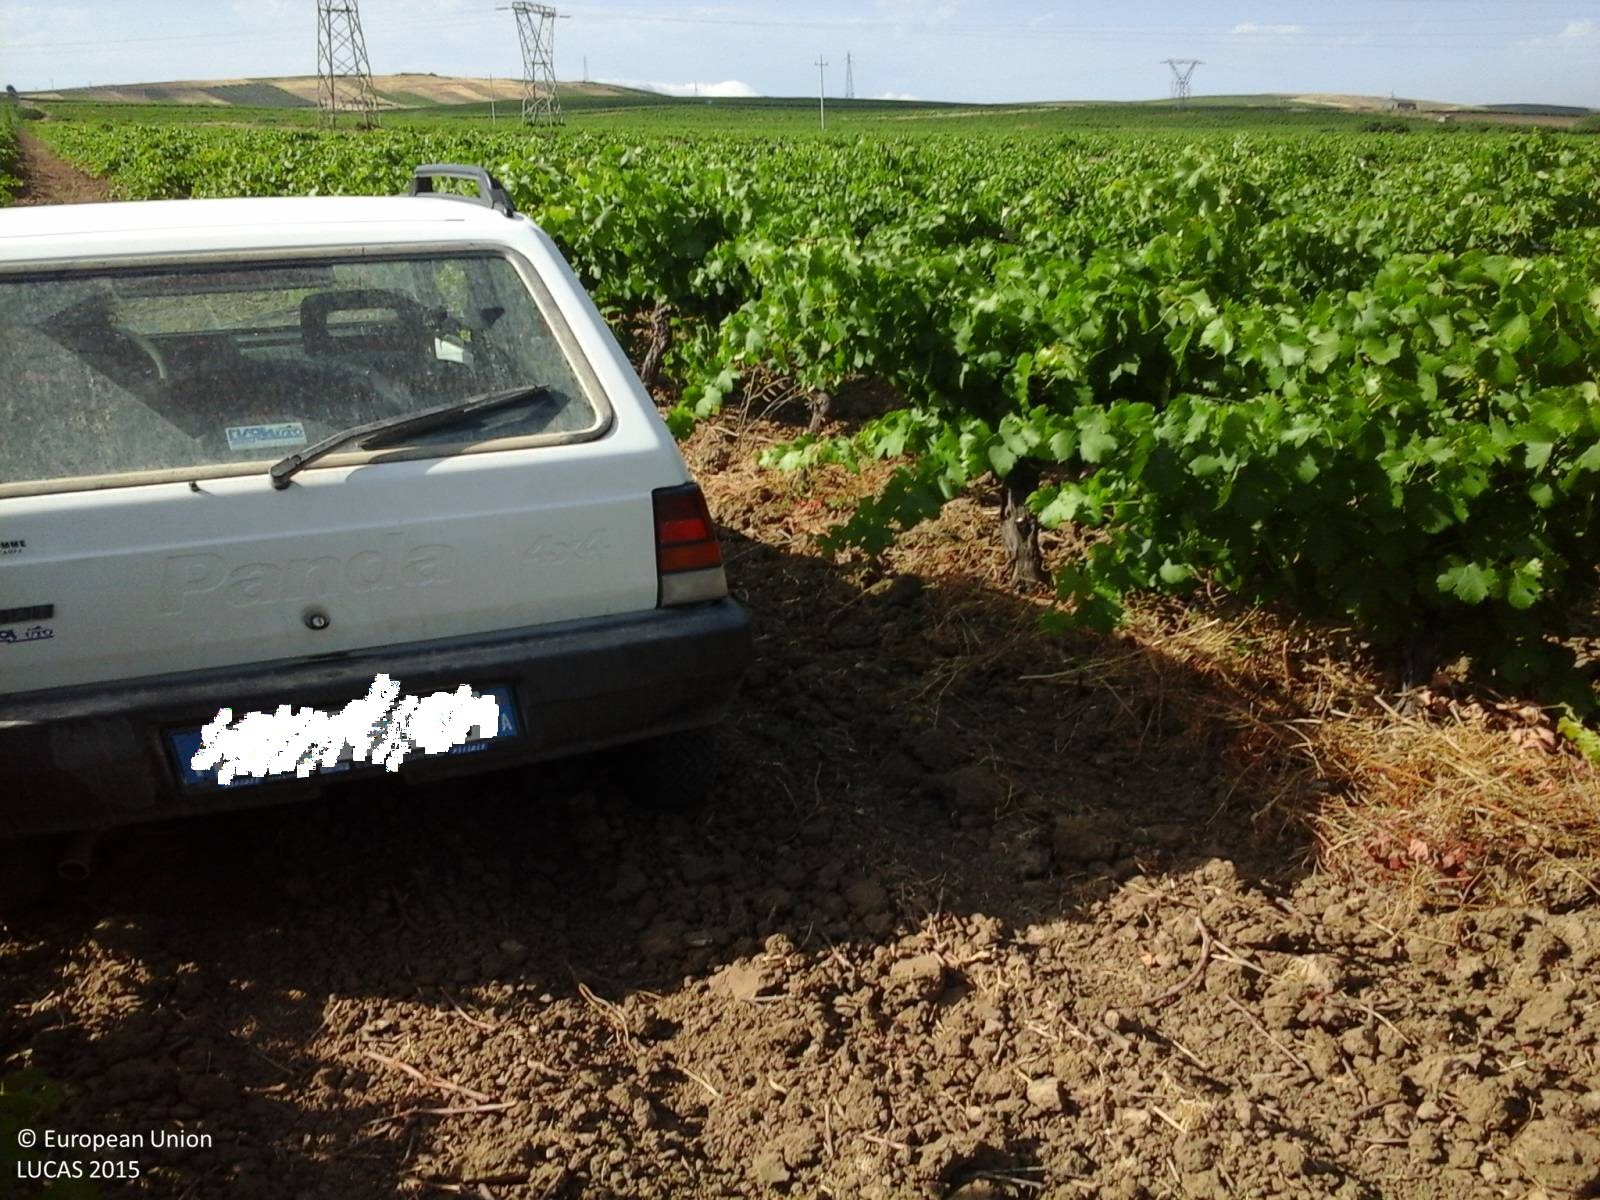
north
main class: Cropland
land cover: Vineyards
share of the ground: 50 - 75 %
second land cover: Other bare soil
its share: > 75 %
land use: Agriculture (excluding fallow land and kitchen gardens)
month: June
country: IT
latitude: 37.8759
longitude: 12.5844
